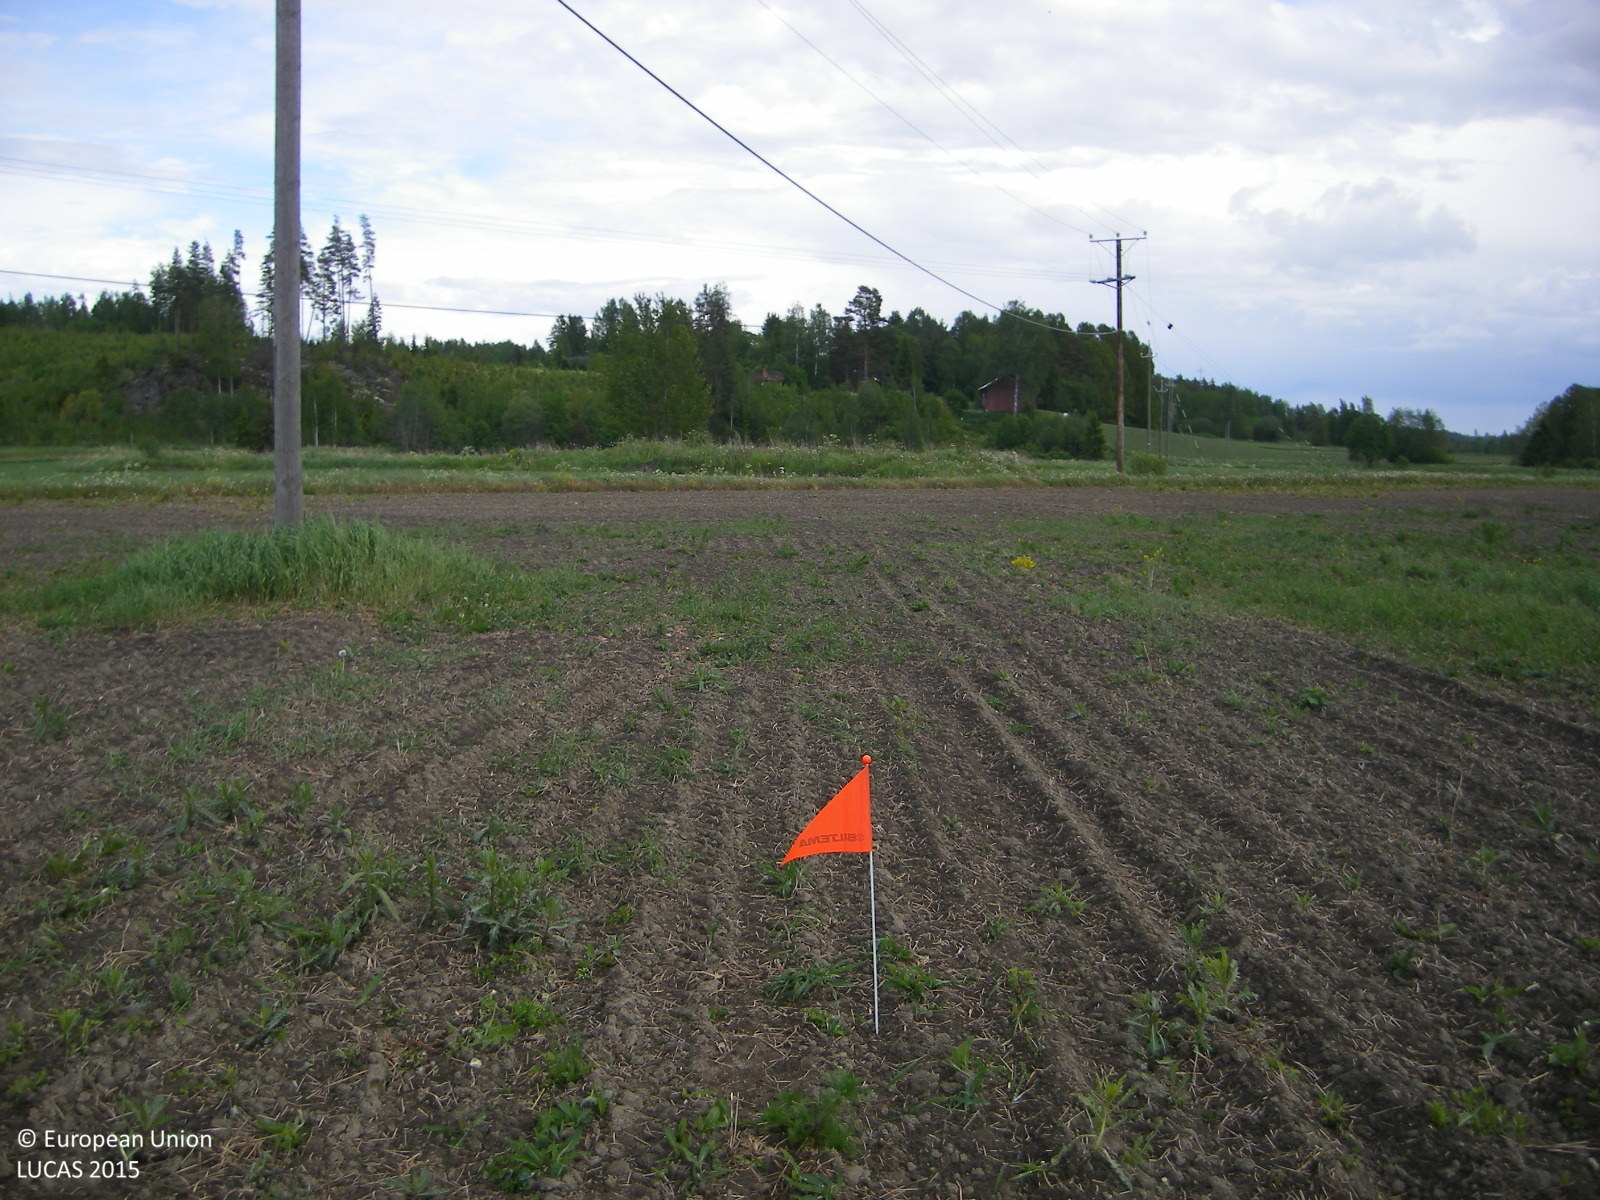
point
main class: Cropland
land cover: Common wheat
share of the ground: 10 - 25 %
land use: Agriculture (excluding fallow land and kitchen gardens)
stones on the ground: < 10 %
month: June
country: FI
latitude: 60.4226
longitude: 24.6211
